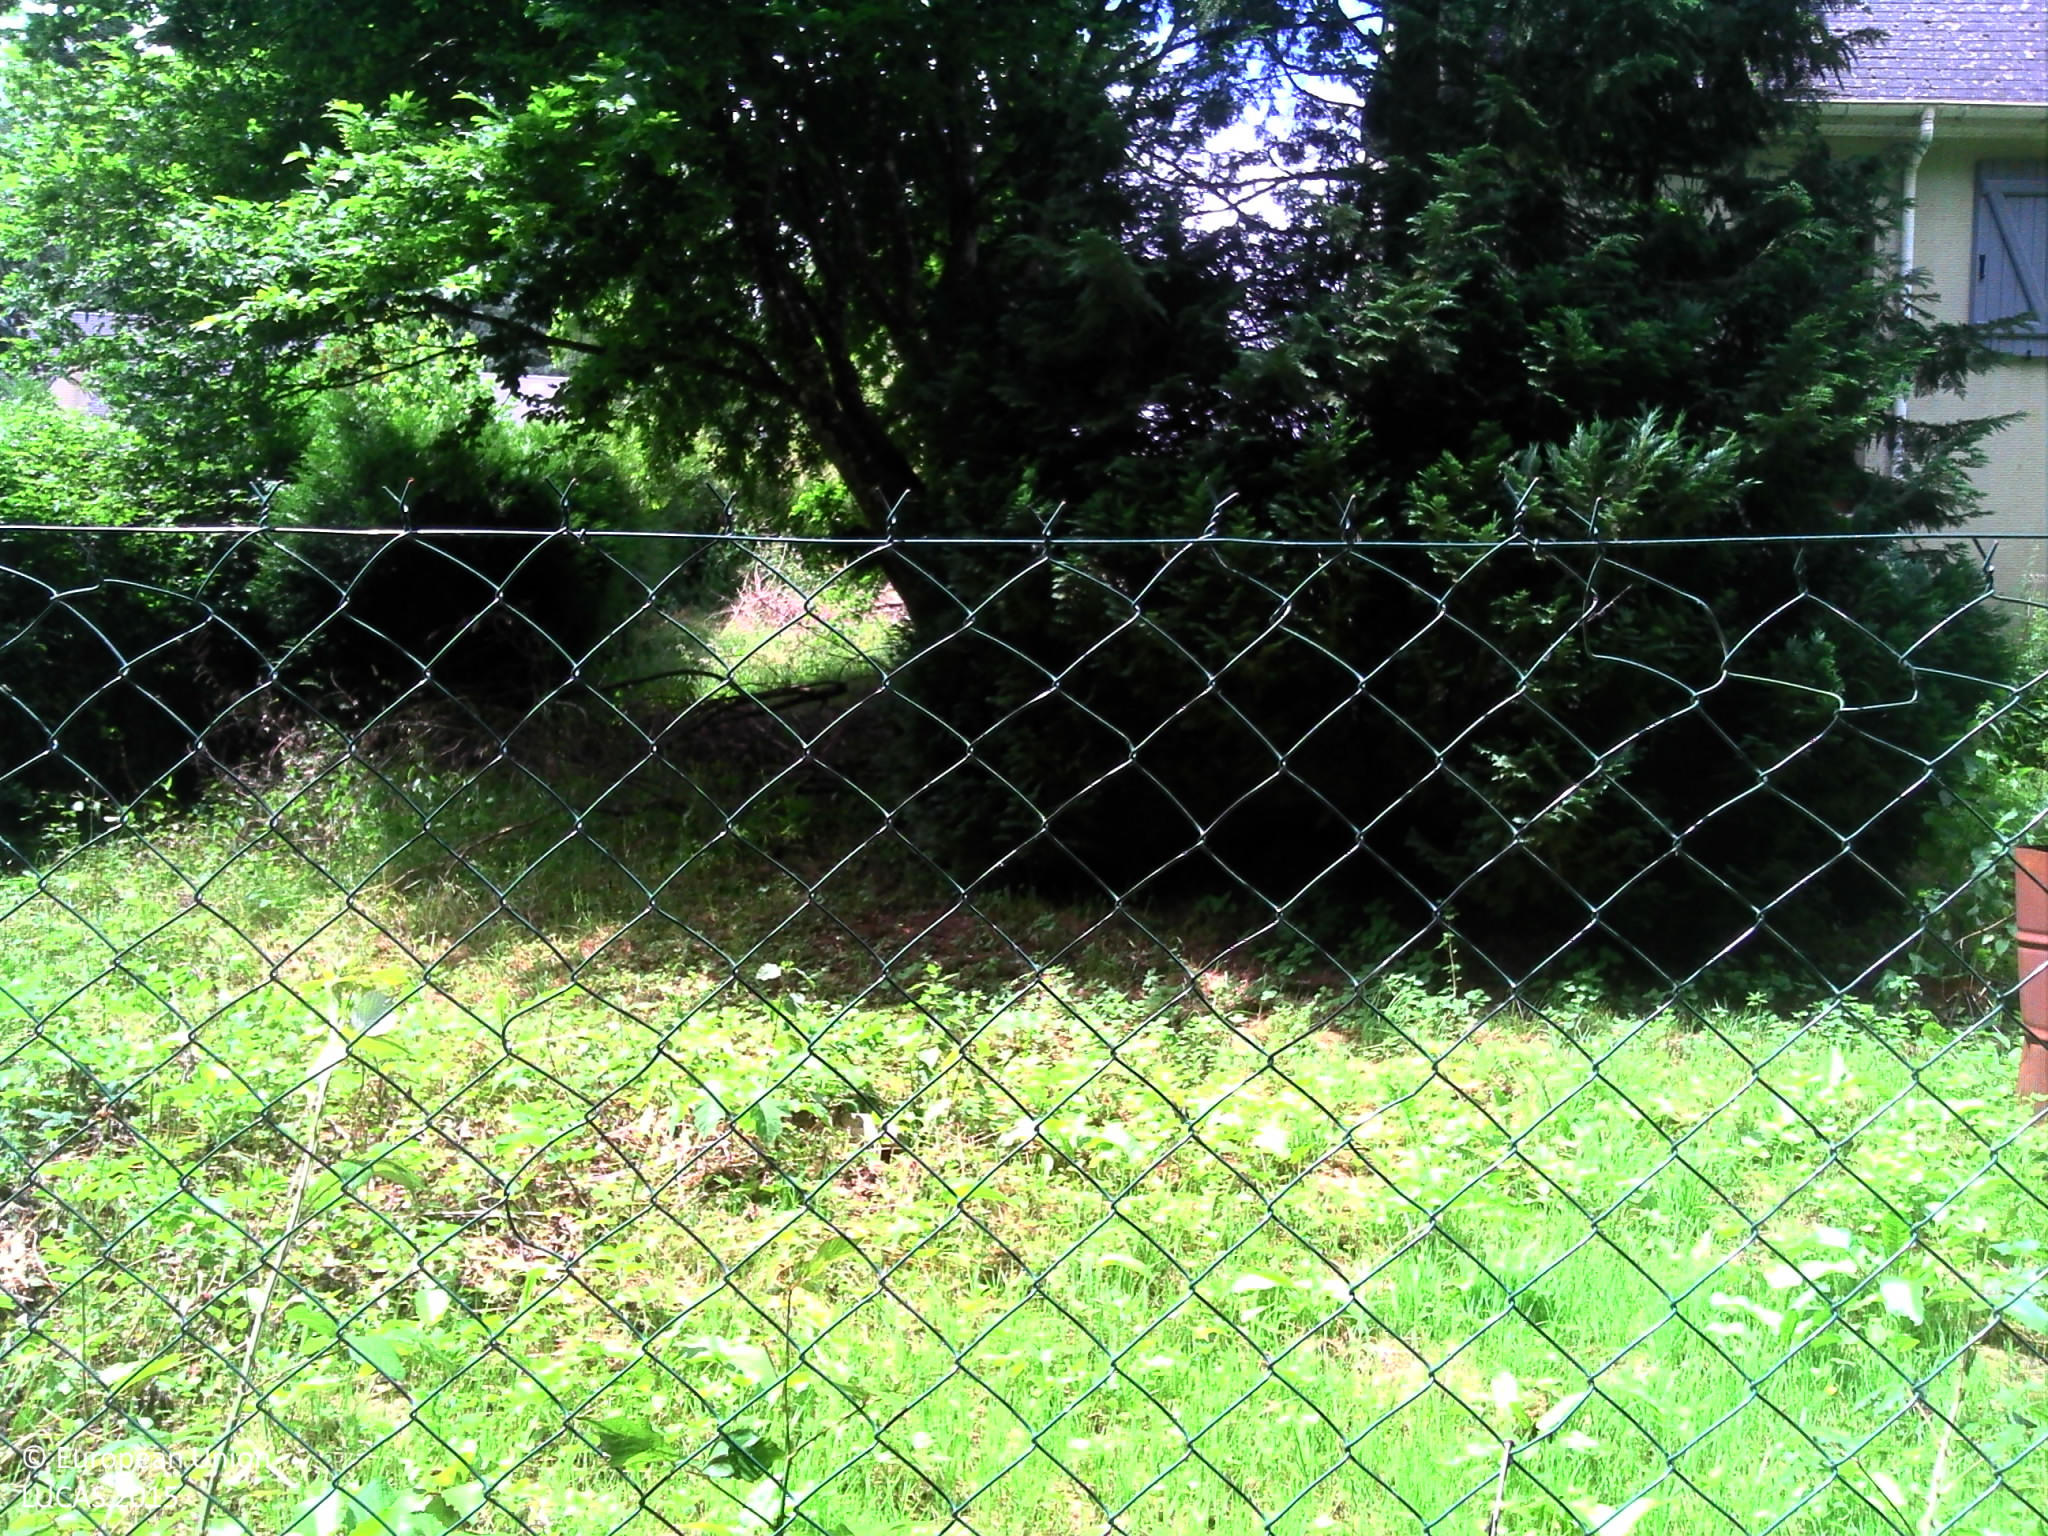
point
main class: Woodland
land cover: Spruce dominated mixed woodland
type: exotic forest
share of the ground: > 75 %
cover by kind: broadleaved forest trees 45 %, herbaceous plants 30 %, coniferous forest trees 25 %
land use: Residential
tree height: > 5 m
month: June
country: FR
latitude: 47.5438
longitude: 0.7465
